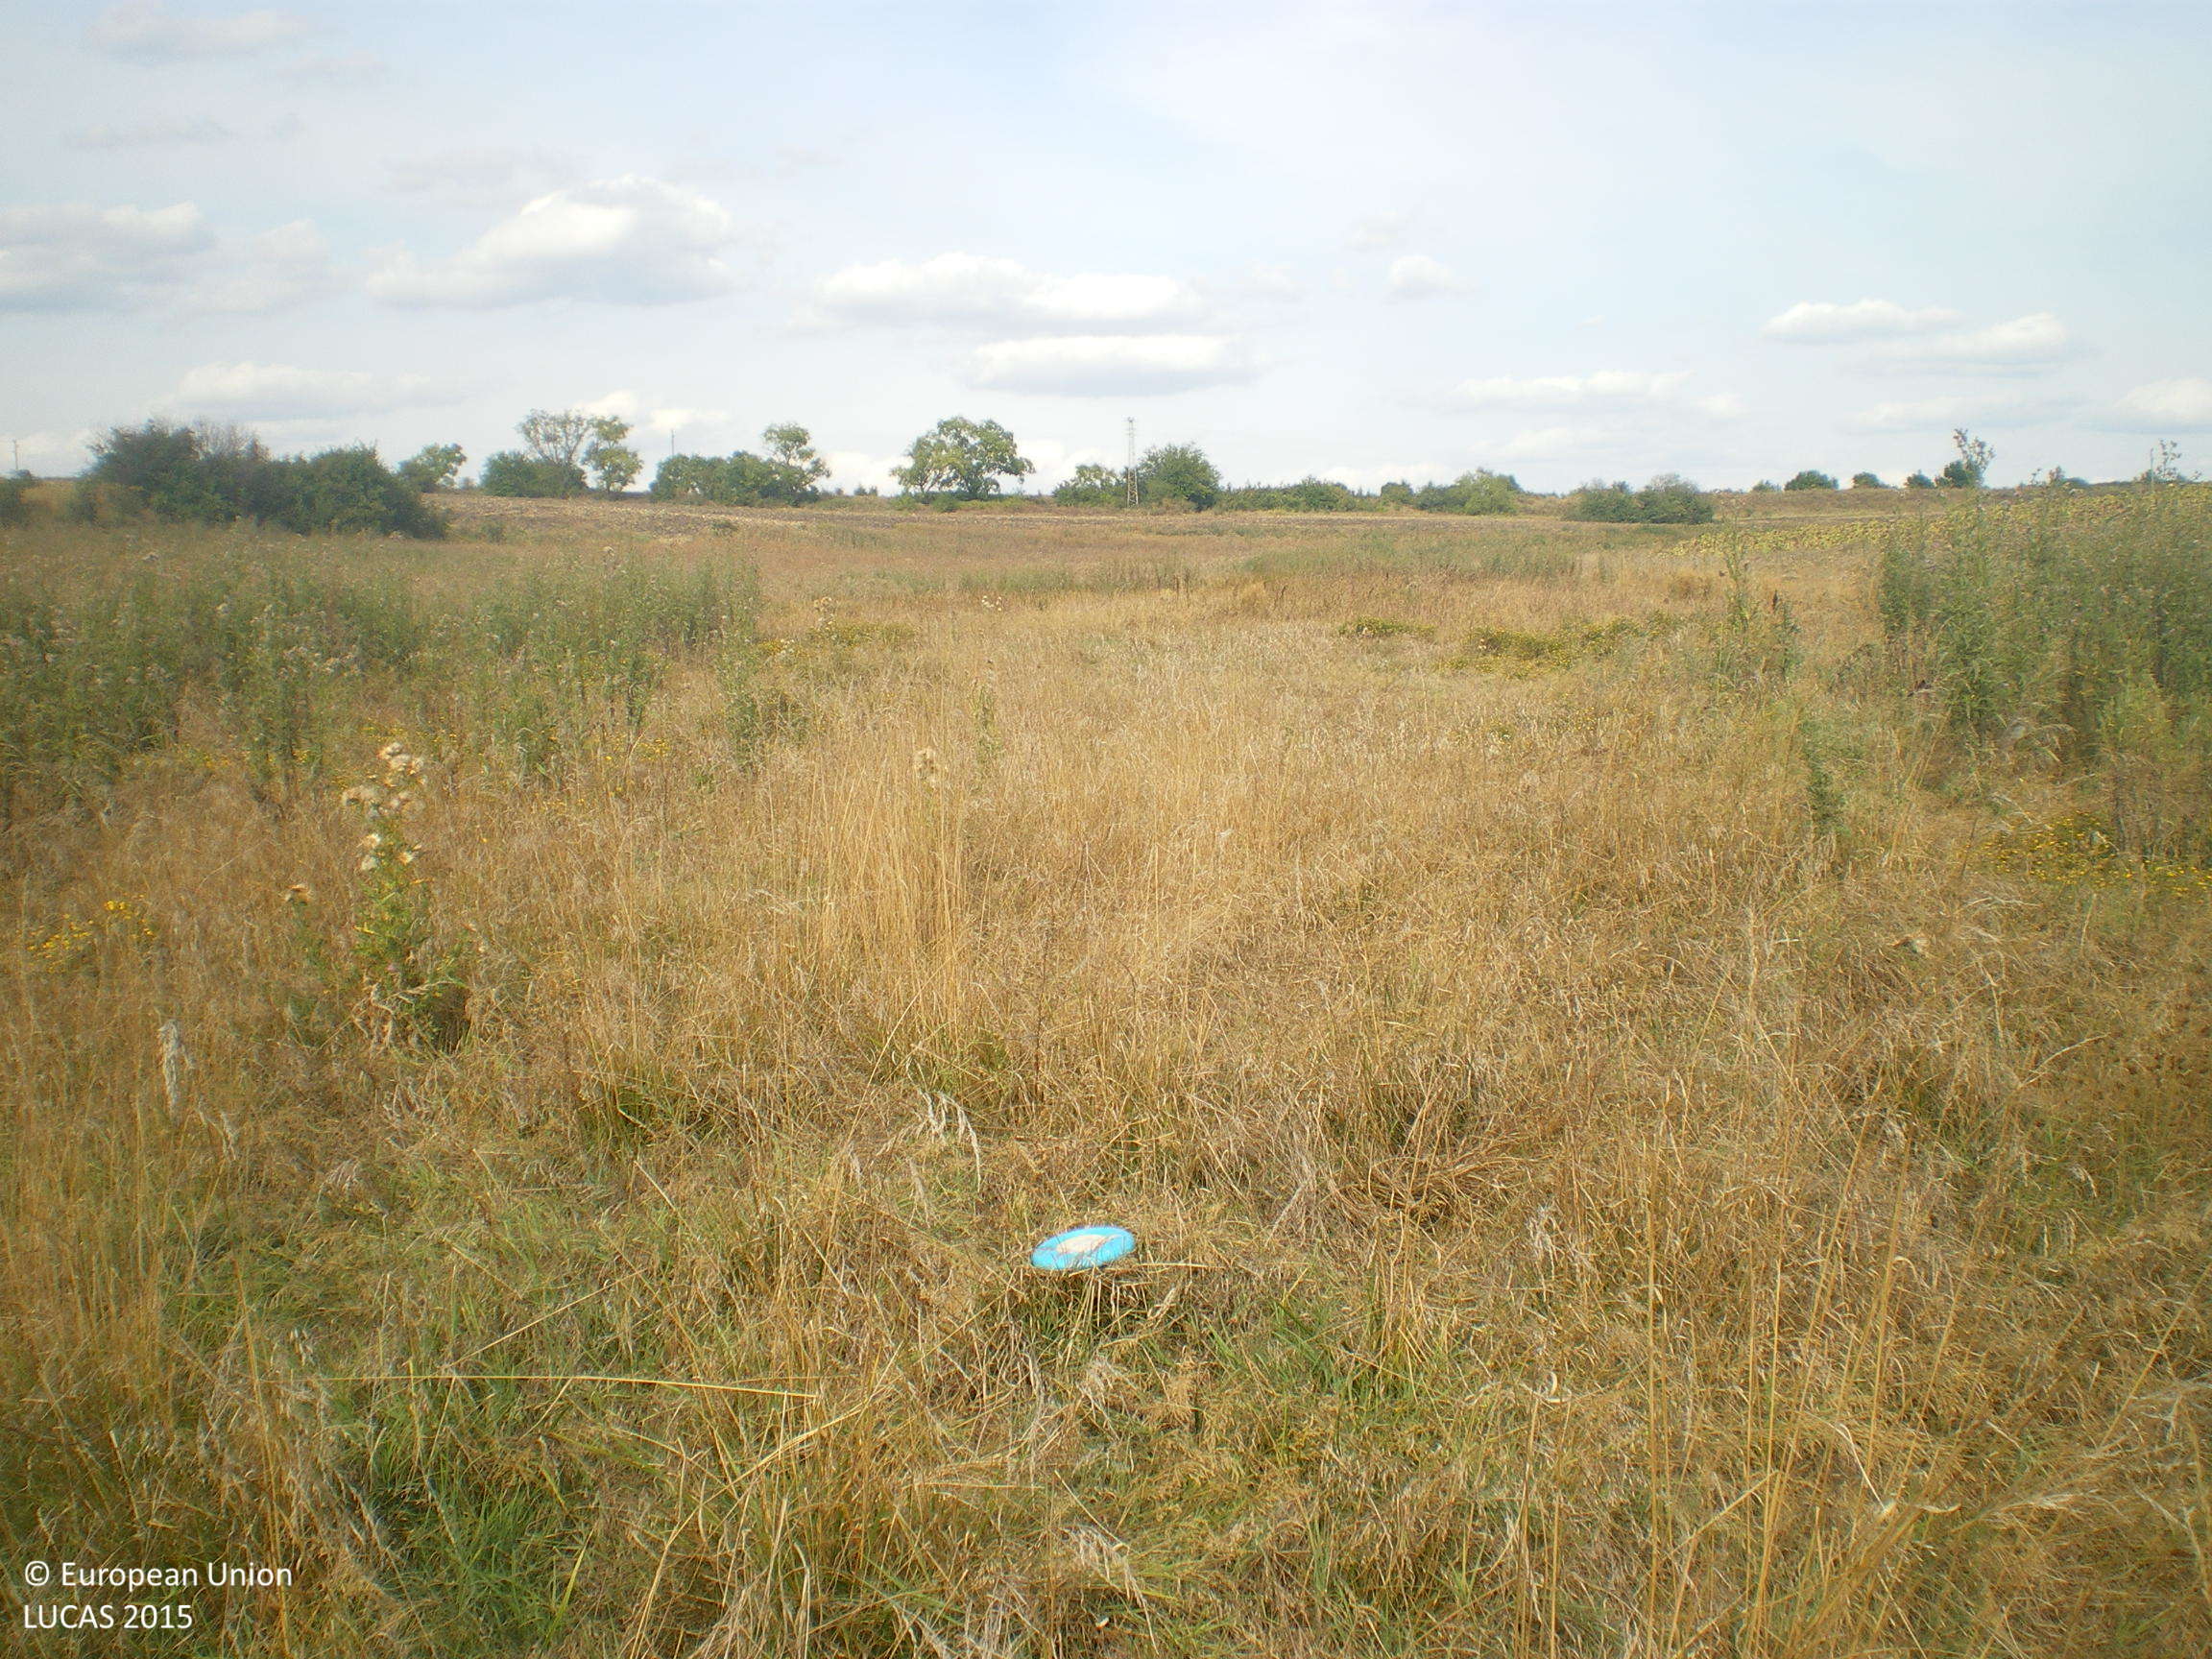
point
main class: Grassland
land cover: Grassland without tree/shrub cover
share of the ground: > 75 %
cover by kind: herbaceous plants 100 %
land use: Agriculture (excluding fallow land and kitchen gardens)
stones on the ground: < 10 %
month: September
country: BG
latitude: 42.2012
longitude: 26.1022
